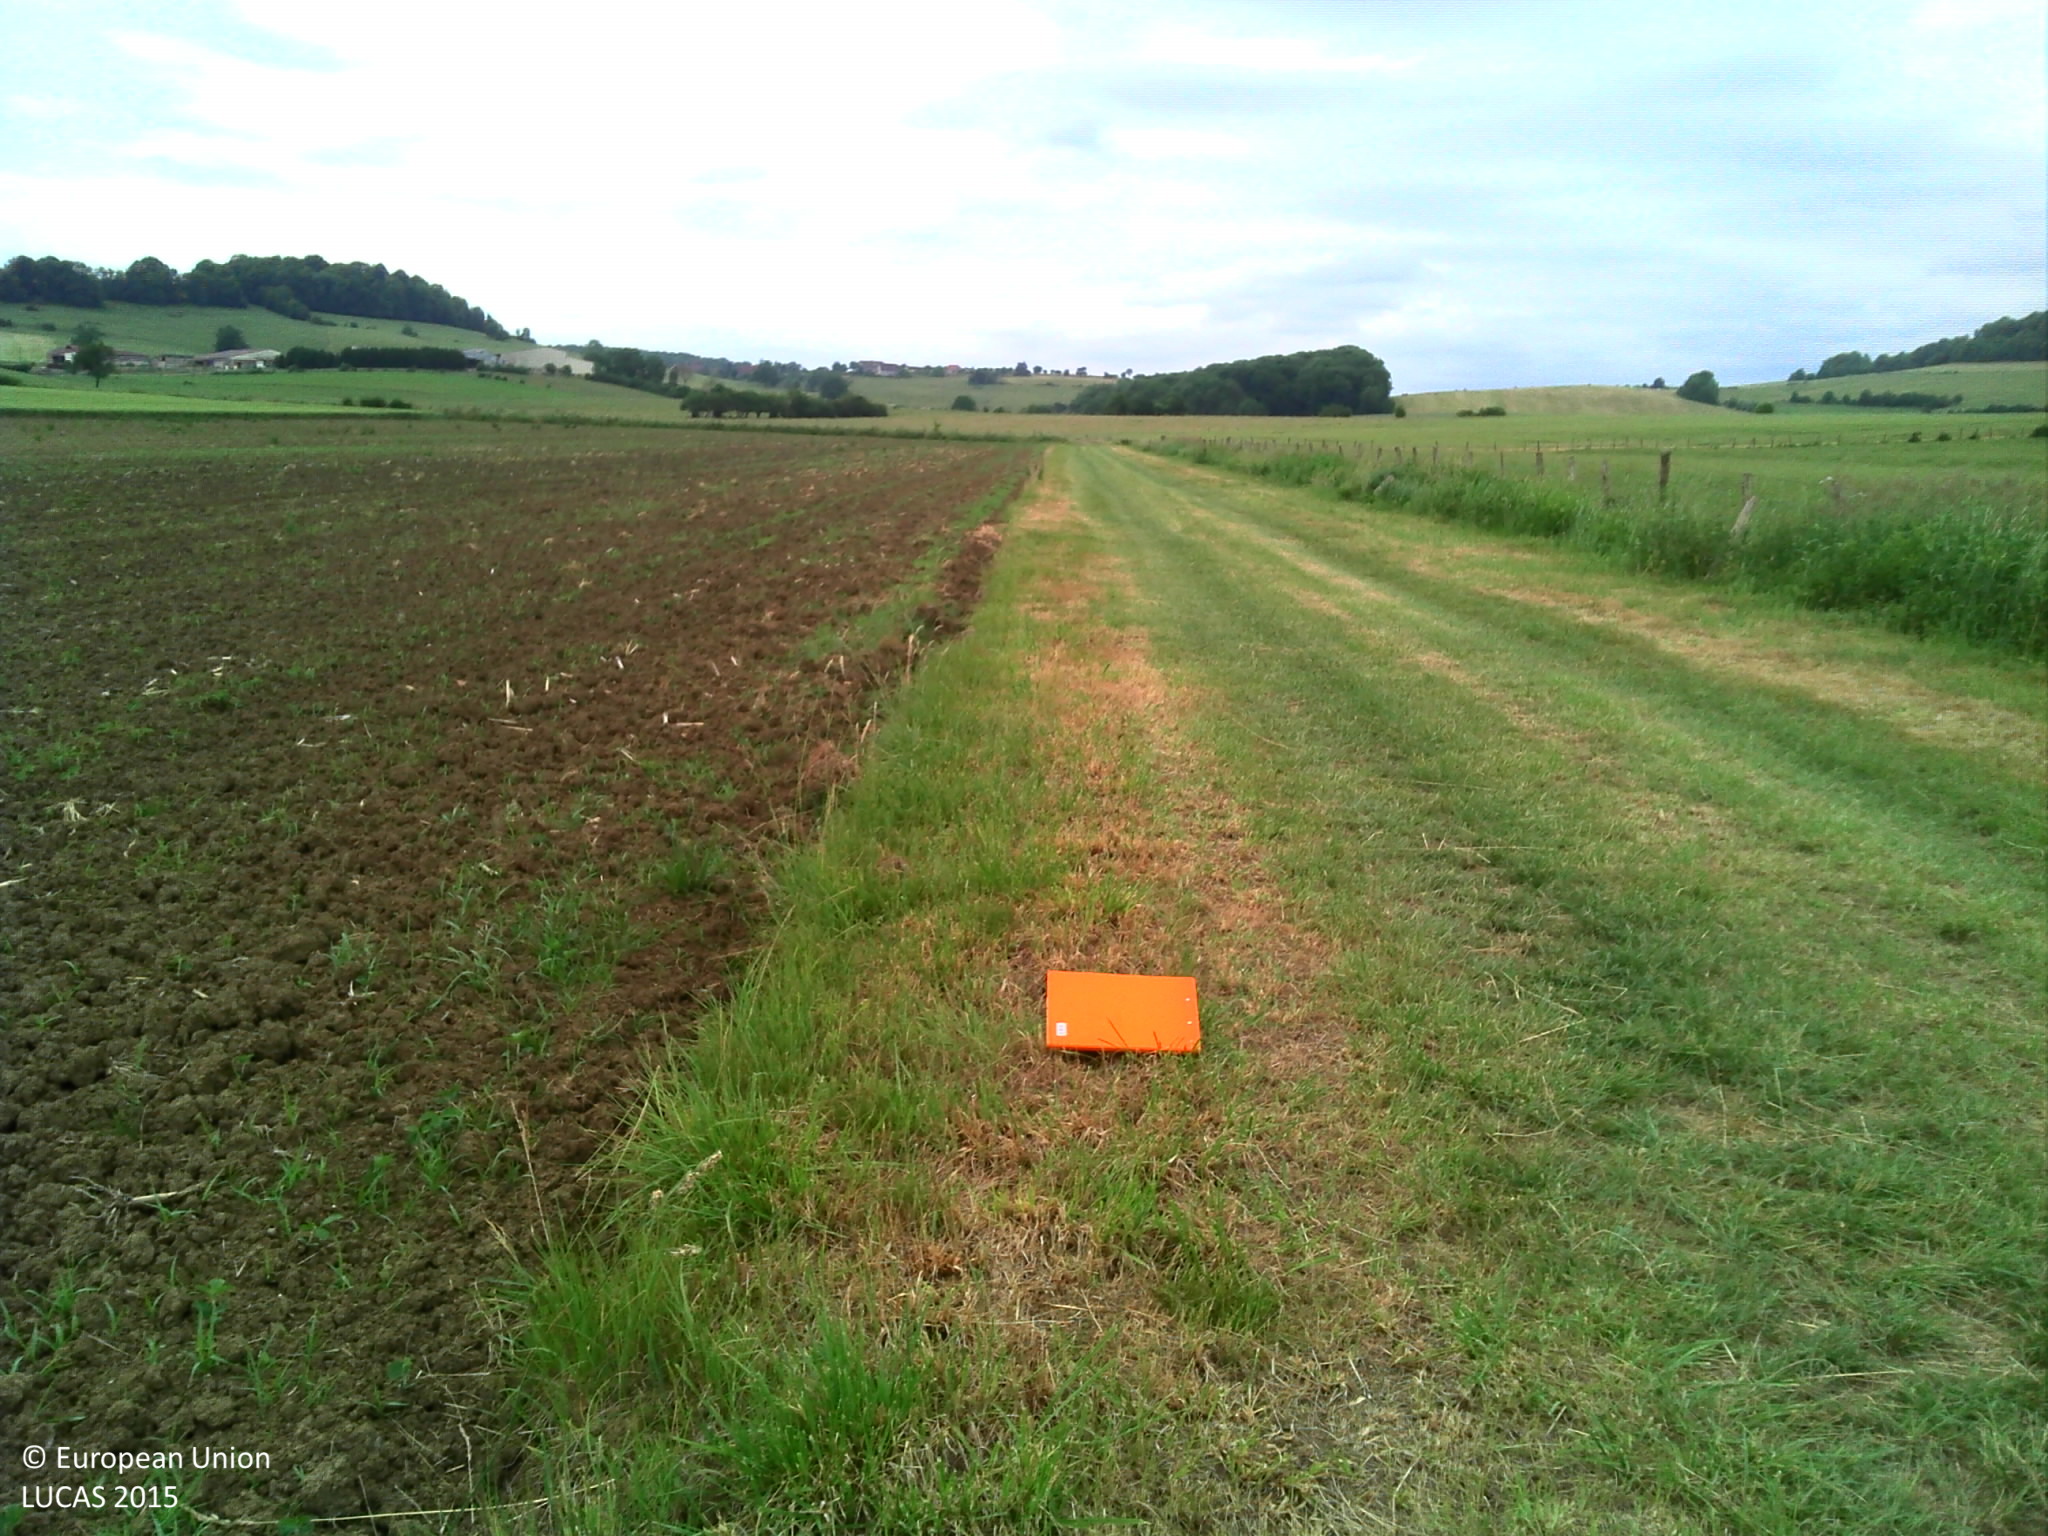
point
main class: Grassland
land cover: Grassland without tree/shrub cover
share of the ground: > 75 %
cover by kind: herbaceous plants 100 %
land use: Agriculture (excluding fallow land and kitchen gardens)
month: June
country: FR
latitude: 47.6233
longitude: 6.3688
